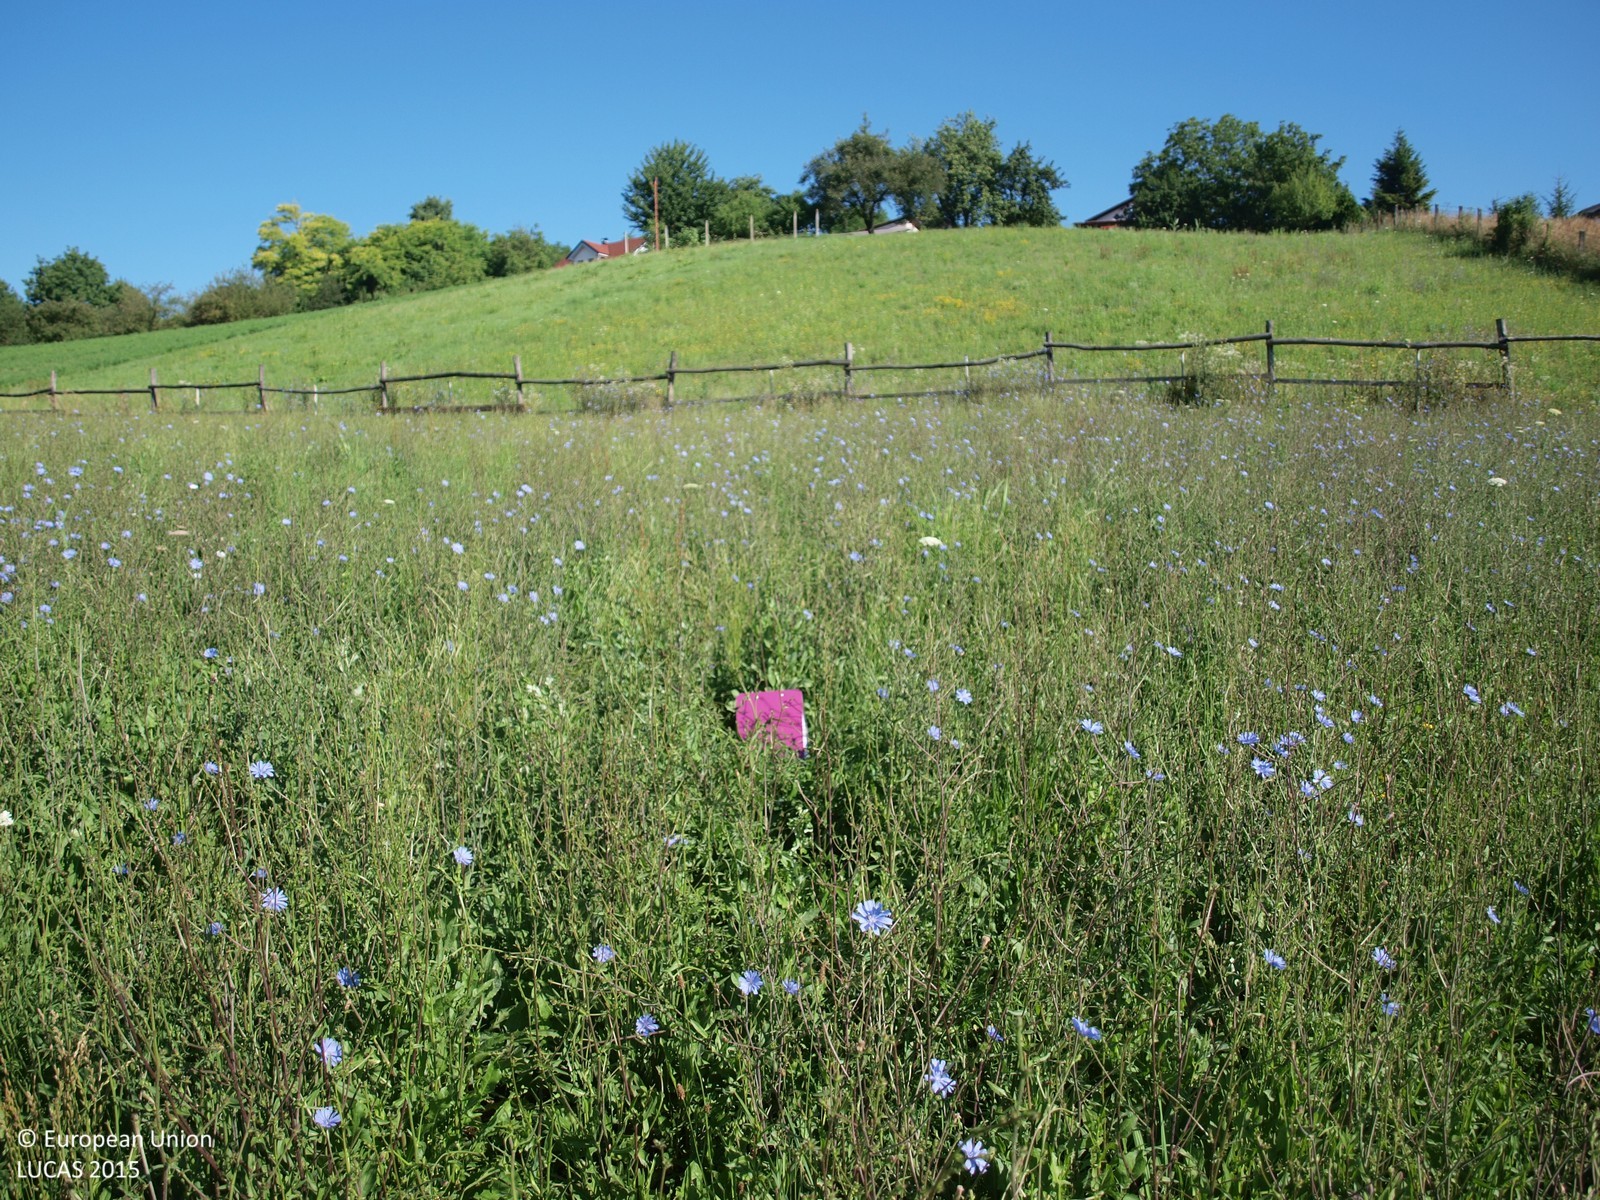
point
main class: Grassland
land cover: Grassland without tree/shrub cover
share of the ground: > 75 %
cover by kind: herbaceous plants 100 %
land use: Agriculture (excluding fallow land and kitchen gardens)
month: July
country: HR
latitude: 45.8919
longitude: 15.7067
